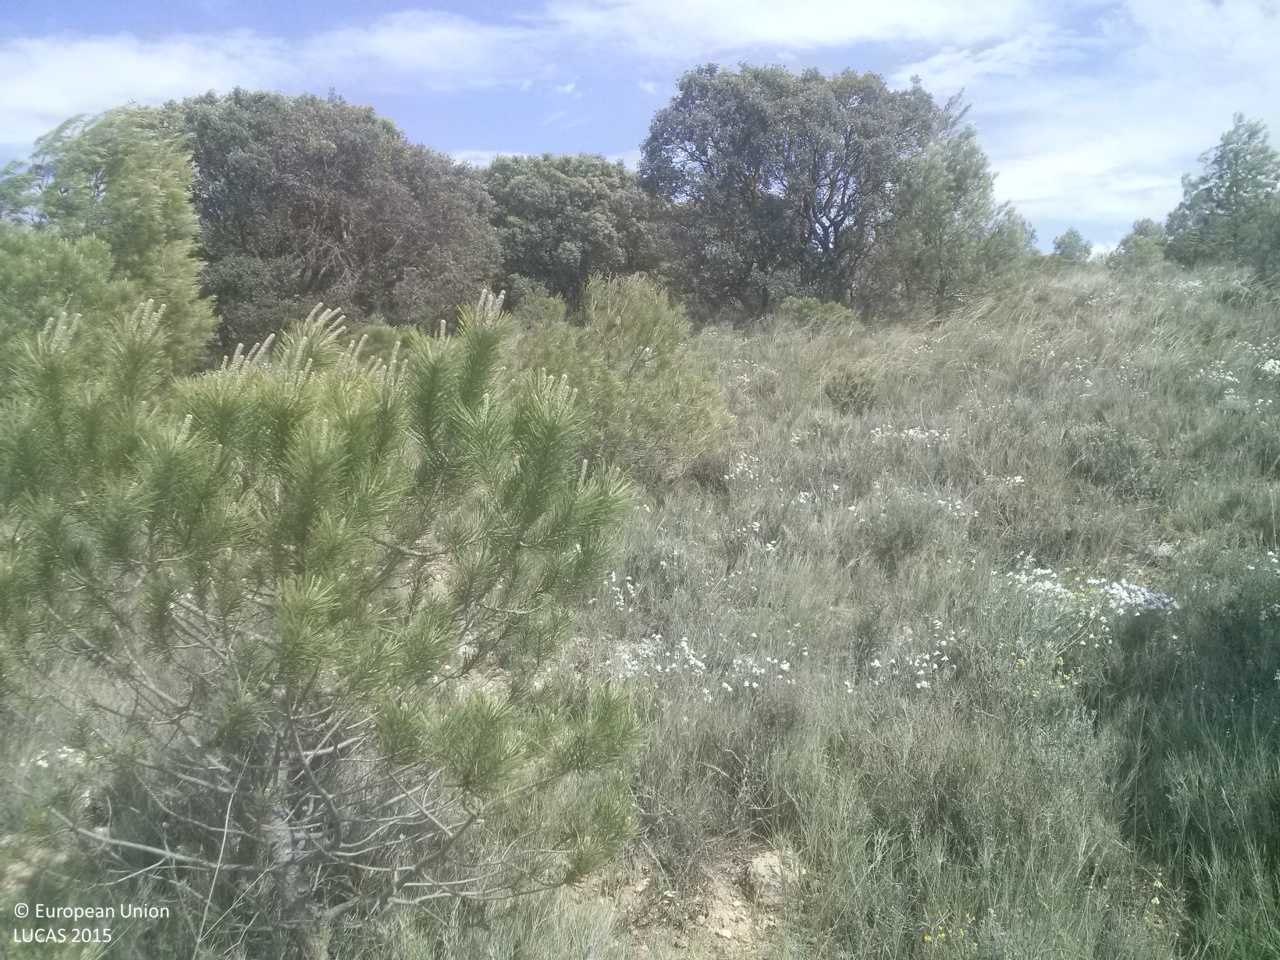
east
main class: Woodland
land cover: Pine dominated mixed woodland
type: coniferous forest of the mediterranean region
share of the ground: 10 - 25 %
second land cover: Shrubland without tree cover
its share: 50 - 75 %
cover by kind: shrubs 55 %, coniferous forest trees 20 %, herbaceous plants 15 %, broadleaved forest trees 10 %
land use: Forestry
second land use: Agriculture (excluding fallow land and kitchen gardens)
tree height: < 5 m
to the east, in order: Pine dominated mixed woodland; Shrubland without tree cover; Pine dominated mixed woodland; Grassland without tree/shrub cover; Barley; Grassland without tree/shrub cover; Grassland with sparse tree/shrub cover; Grassland without tree/shrub cover
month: May
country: ES
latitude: 40.0158
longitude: -2.8985
